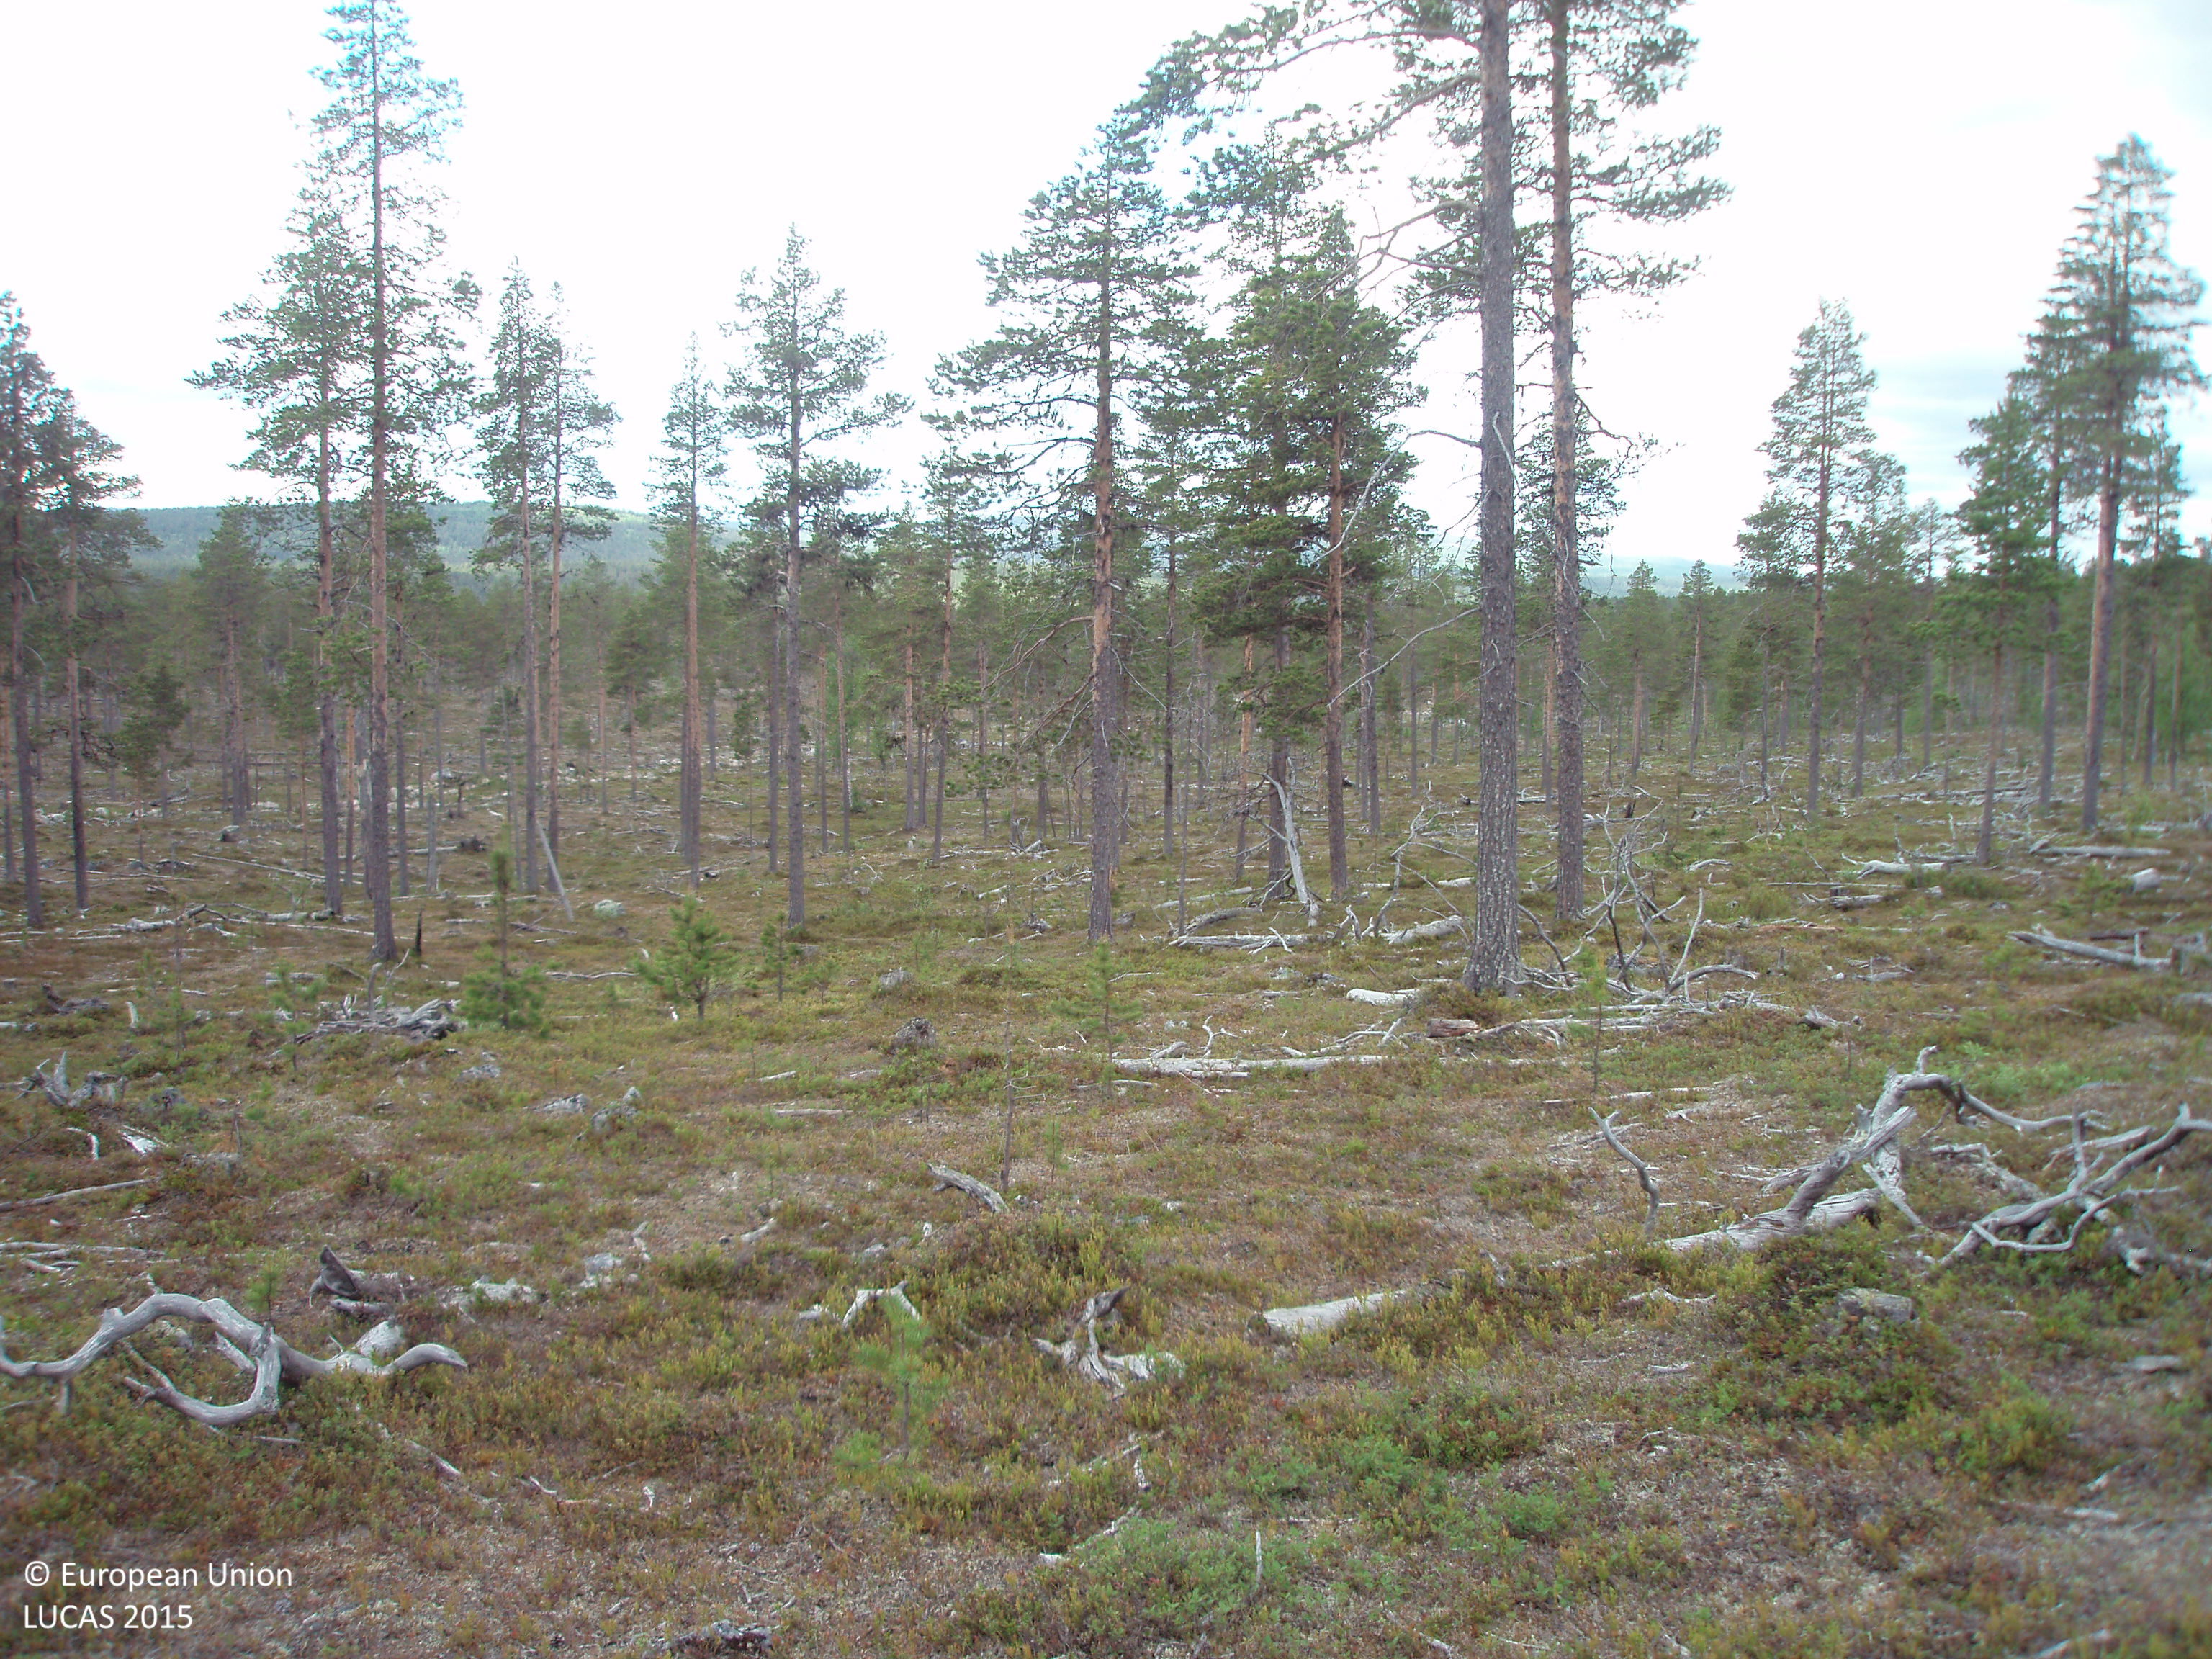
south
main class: Woodland
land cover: Pine dominated coniferous woodland
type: boreal forest
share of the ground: 10 - 25 %
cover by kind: shrubs 65 %, coniferous forest trees 15 %, lichens and mosses 15 %, unconsolidated bare surface 5 %
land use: Forestry
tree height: > 5 m
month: July
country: FI
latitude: 68.8783
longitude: 25.9249
